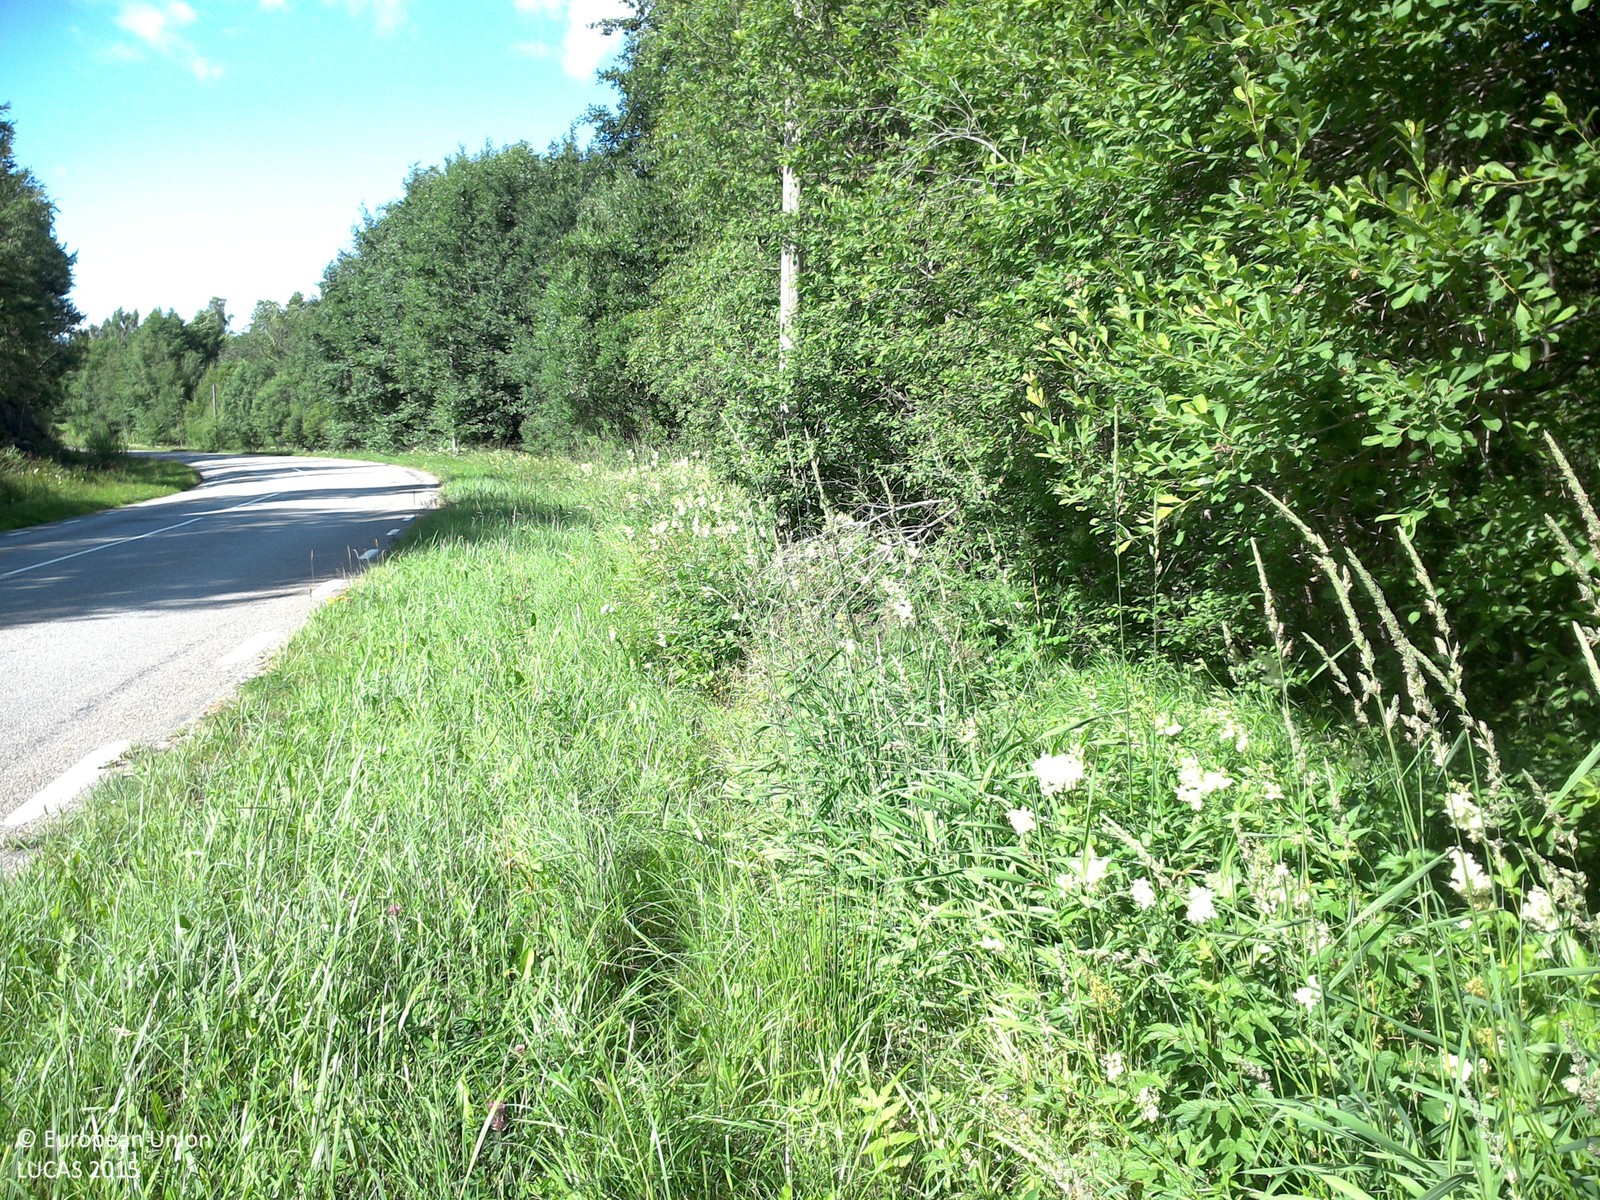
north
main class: Grassland
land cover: Grassland without tree/shrub cover
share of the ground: > 75 %
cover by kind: herbaceous plants 100 %
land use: Road transport
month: July
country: SE
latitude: 58.1362
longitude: 14.7329
